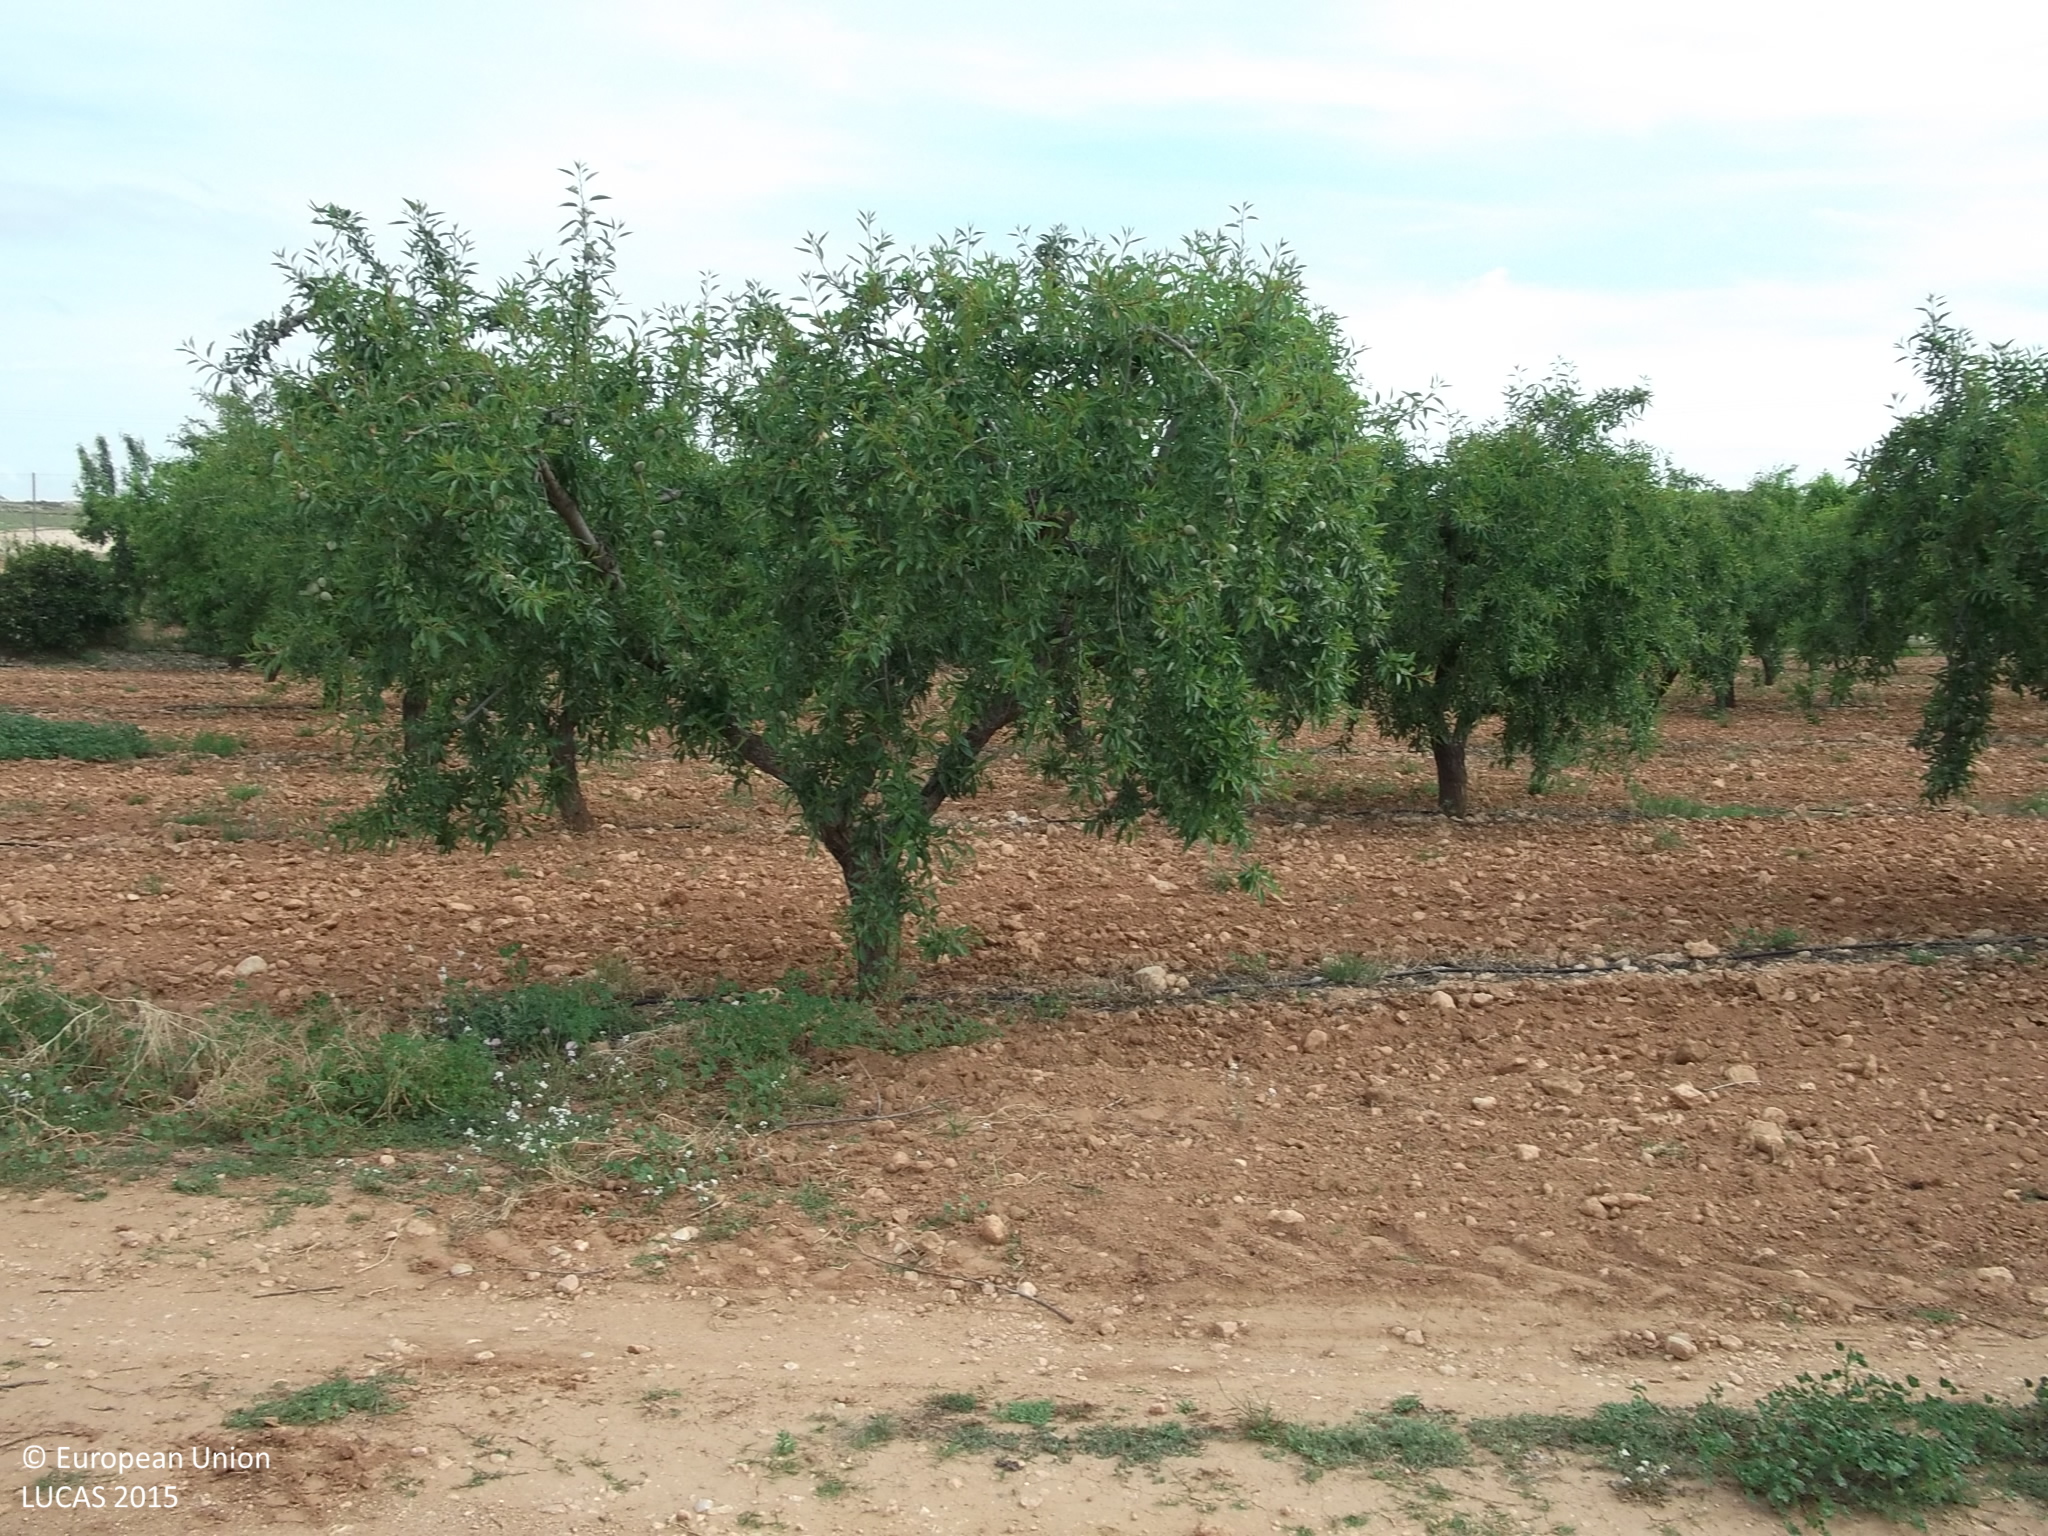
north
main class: Cropland
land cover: Nuts trees
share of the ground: 10 - 25 %
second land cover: Other bare soil
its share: > 75 %
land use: Agriculture (excluding fallow land and kitchen gardens)
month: April
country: ES
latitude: 37.9148
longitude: -1.4388
